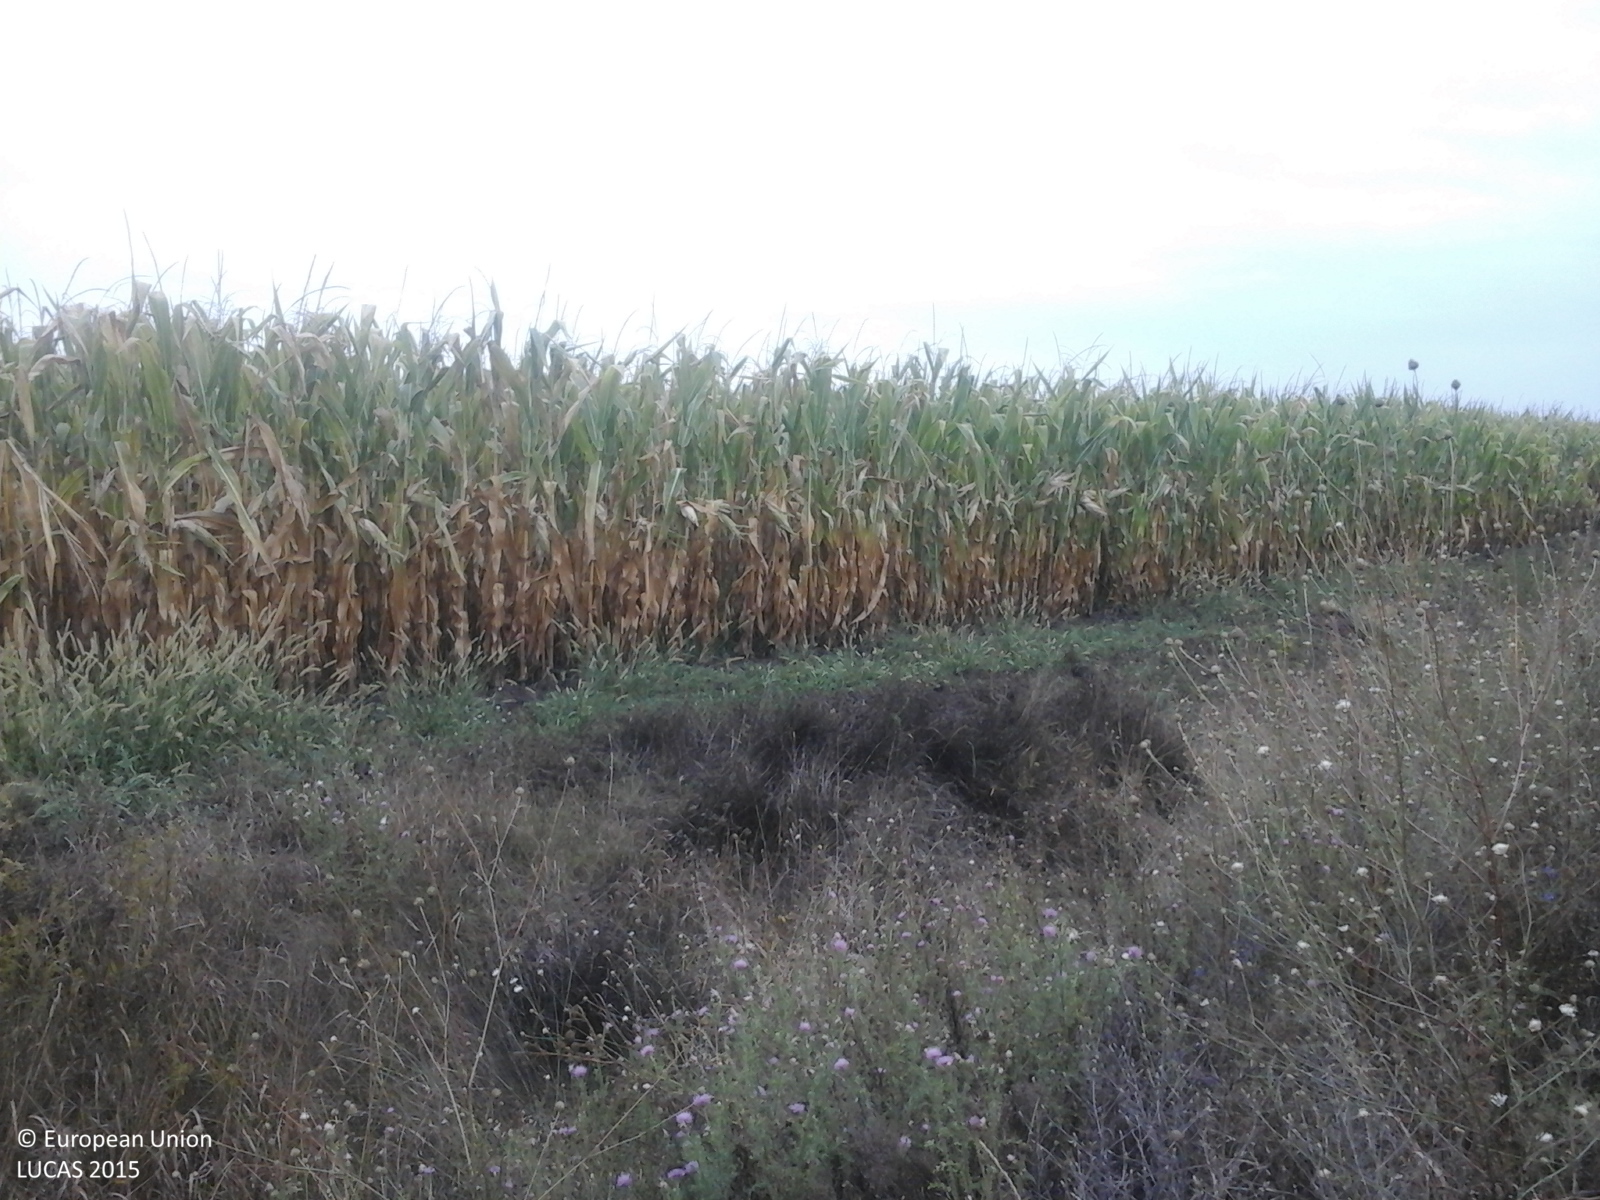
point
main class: Cropland
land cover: Maize
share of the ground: > 75 %
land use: Agriculture (excluding fallow land and kitchen gardens)
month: August
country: RO
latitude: 45.4405
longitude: 21.1372
